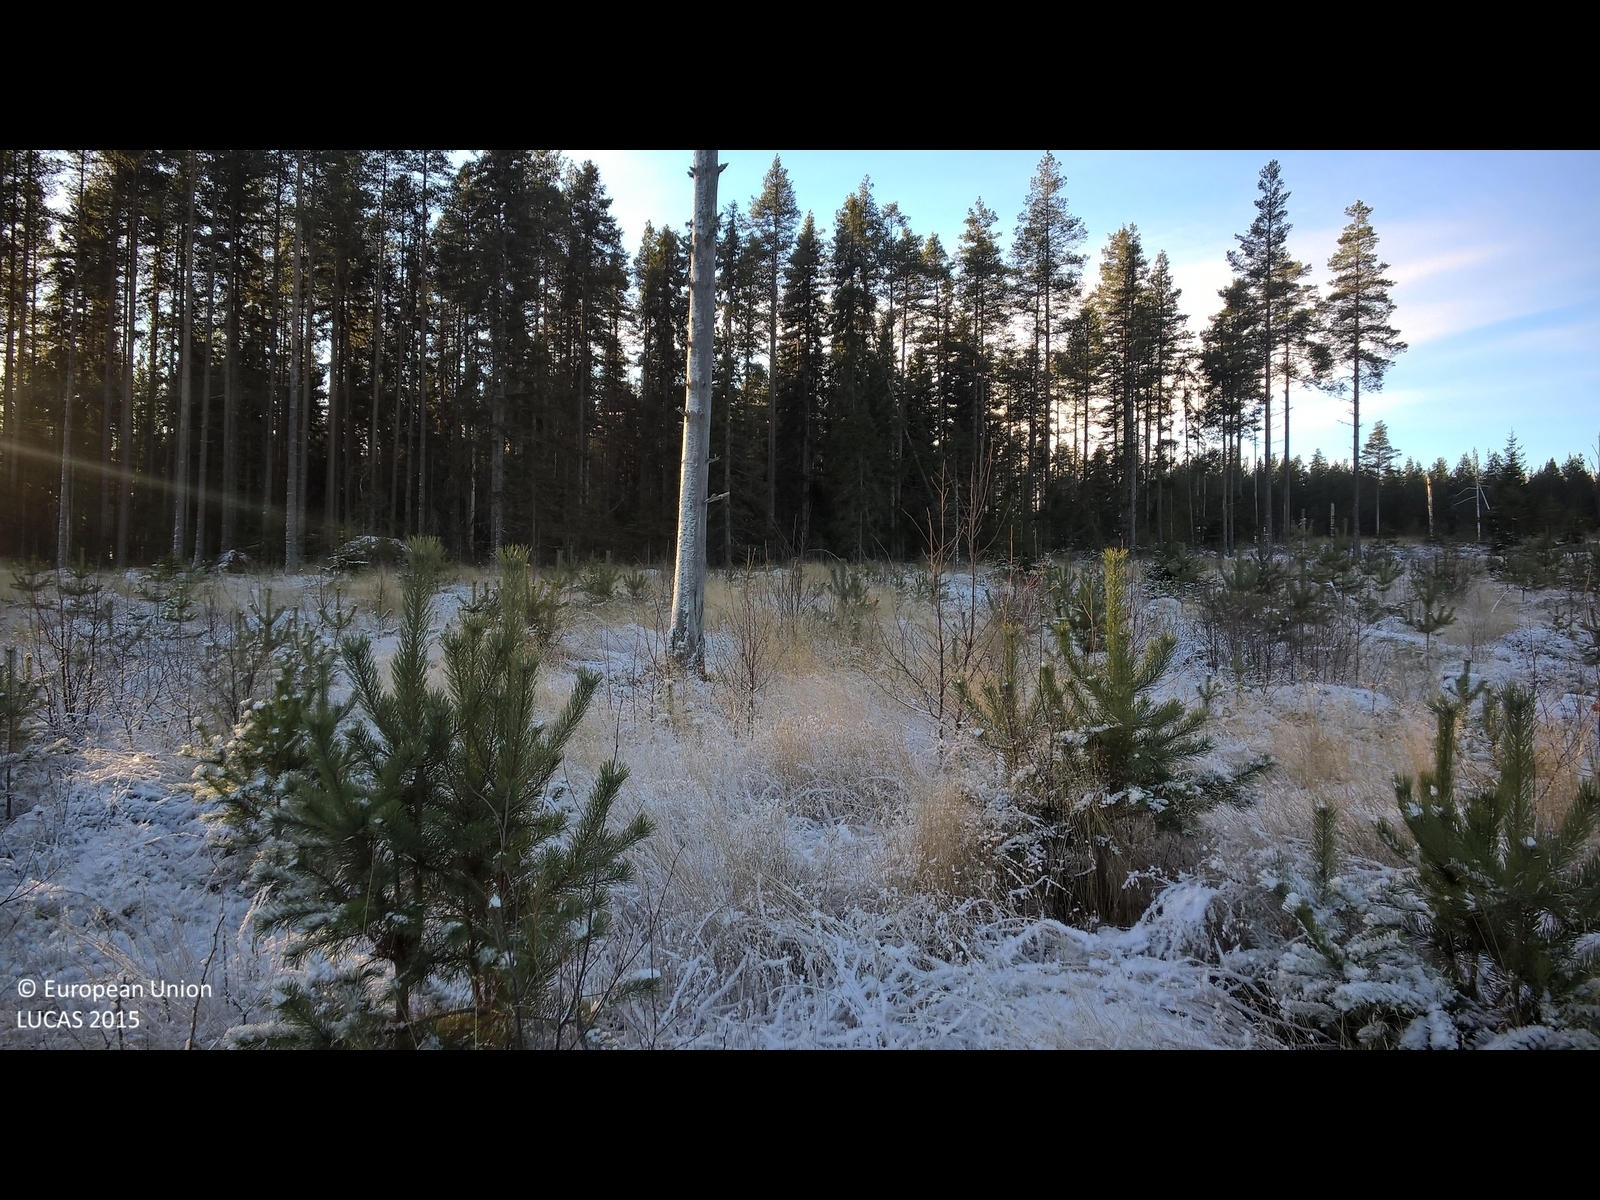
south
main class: Woodland
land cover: Pine dominated coniferous woodland
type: boreal forest
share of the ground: 25 - 50 %
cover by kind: lichens and mosses 60 %, coniferous forest trees 30 %, herbaceous plants 10 %
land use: Forestry
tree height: < 5 m
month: November
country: SE
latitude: 60.7014
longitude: 14.5856
